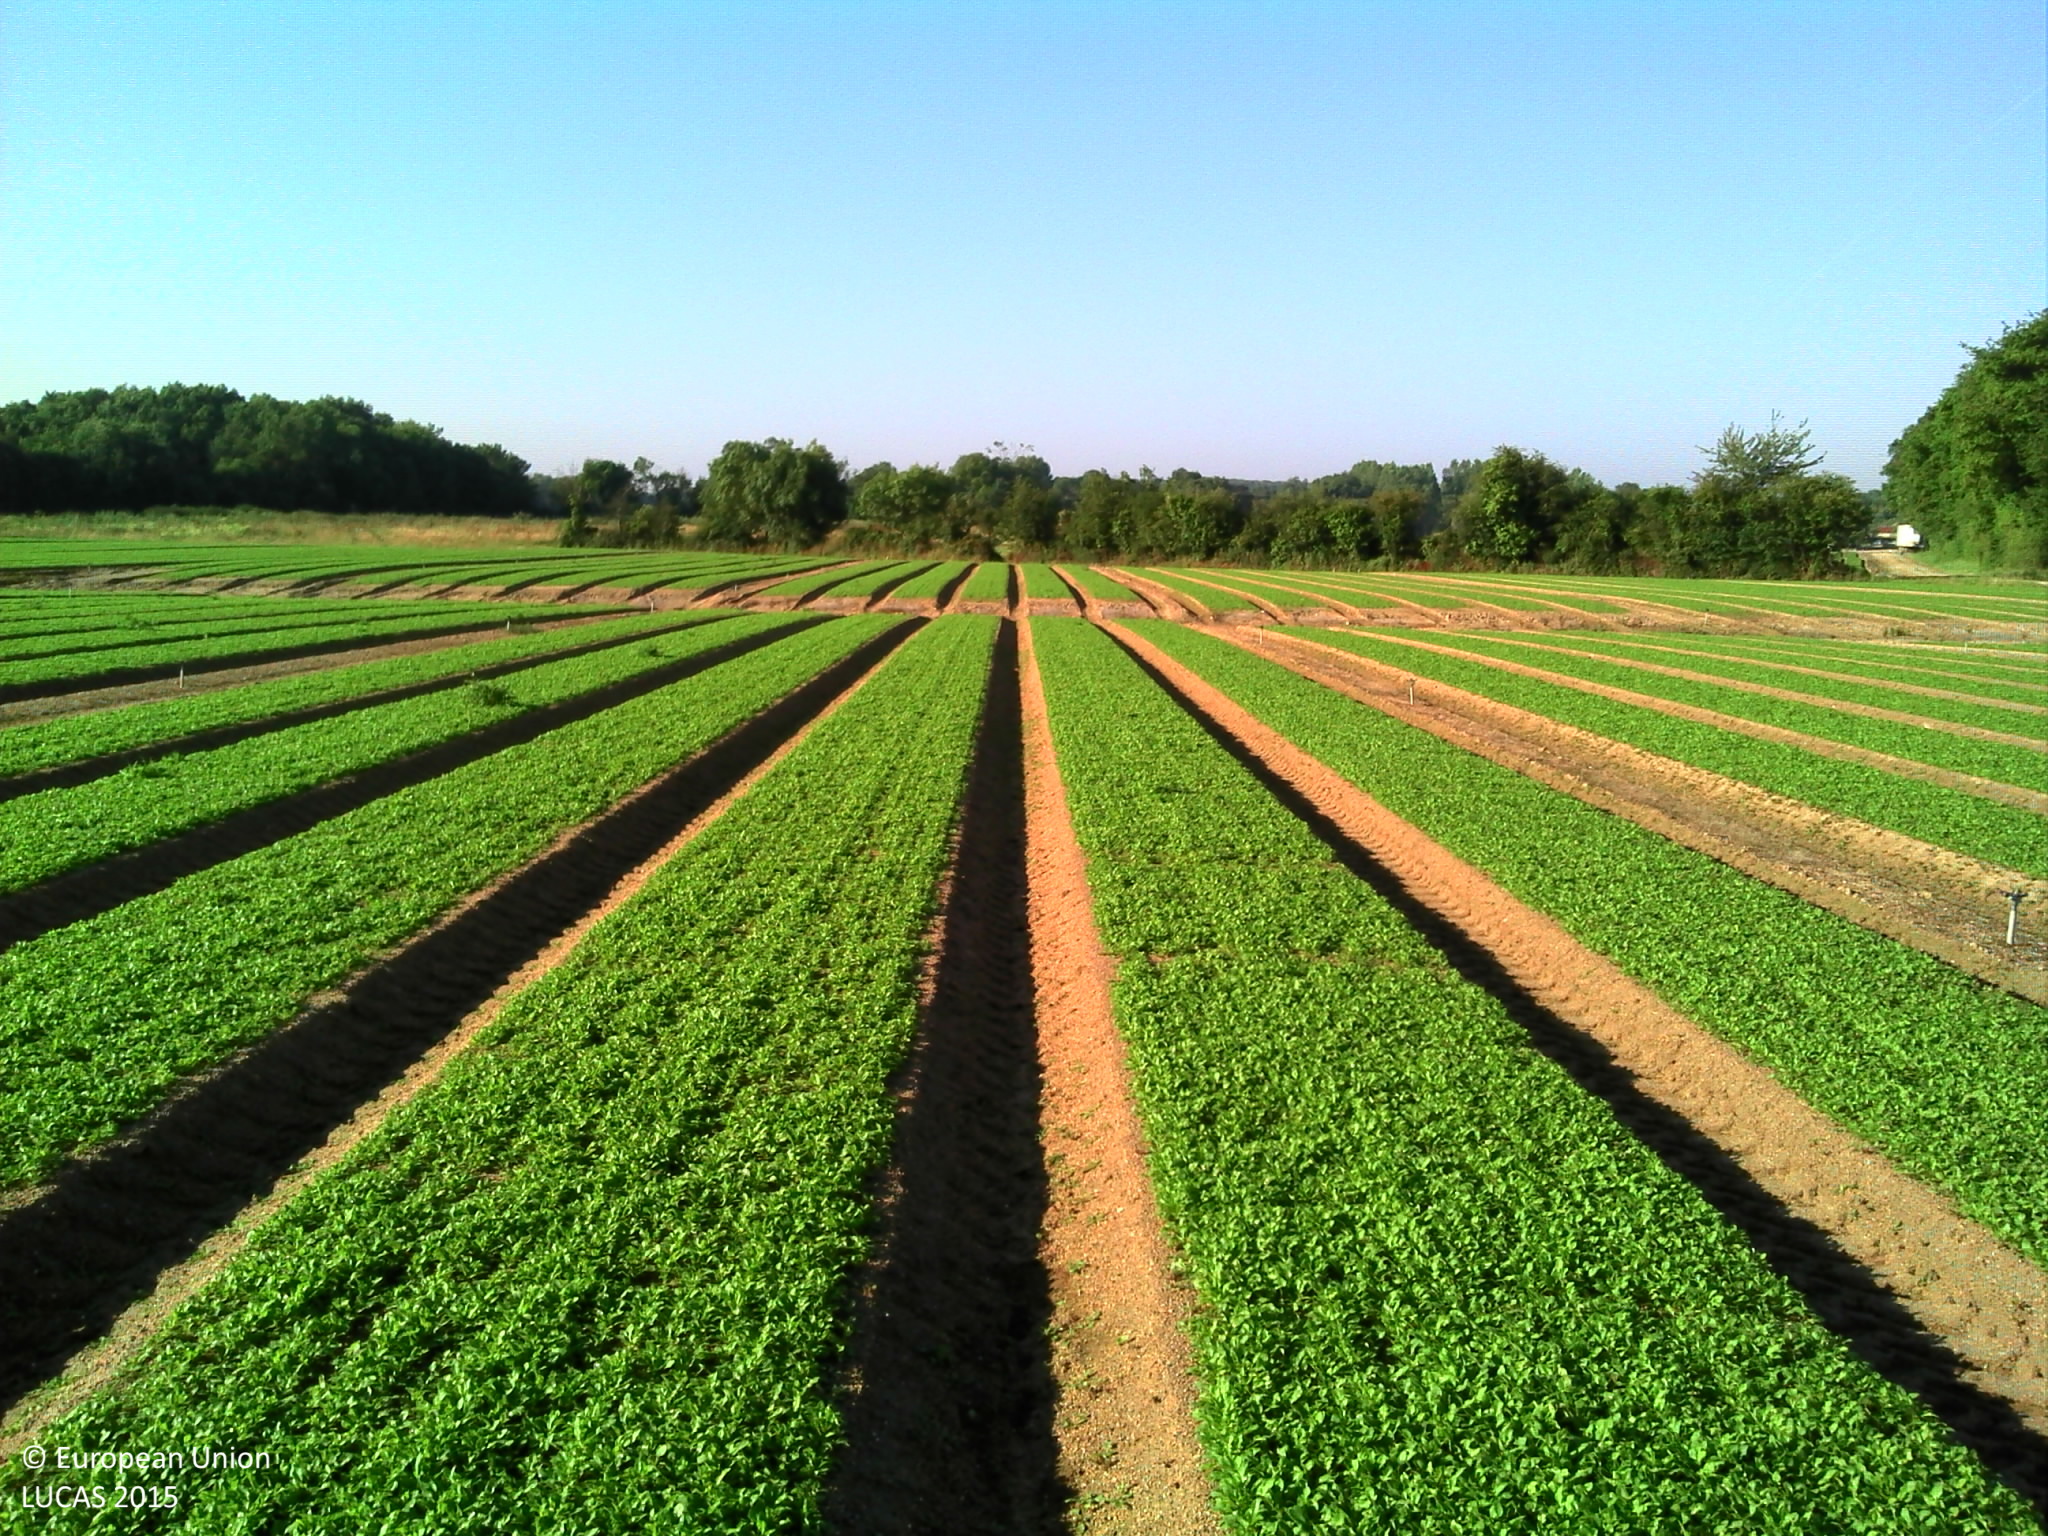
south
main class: Cropland
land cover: Other fresh vegetables
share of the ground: > 75 %
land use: Agriculture (excluding fallow land and kitchen gardens)
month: June
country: FR
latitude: 47.0185
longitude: -1.8456
